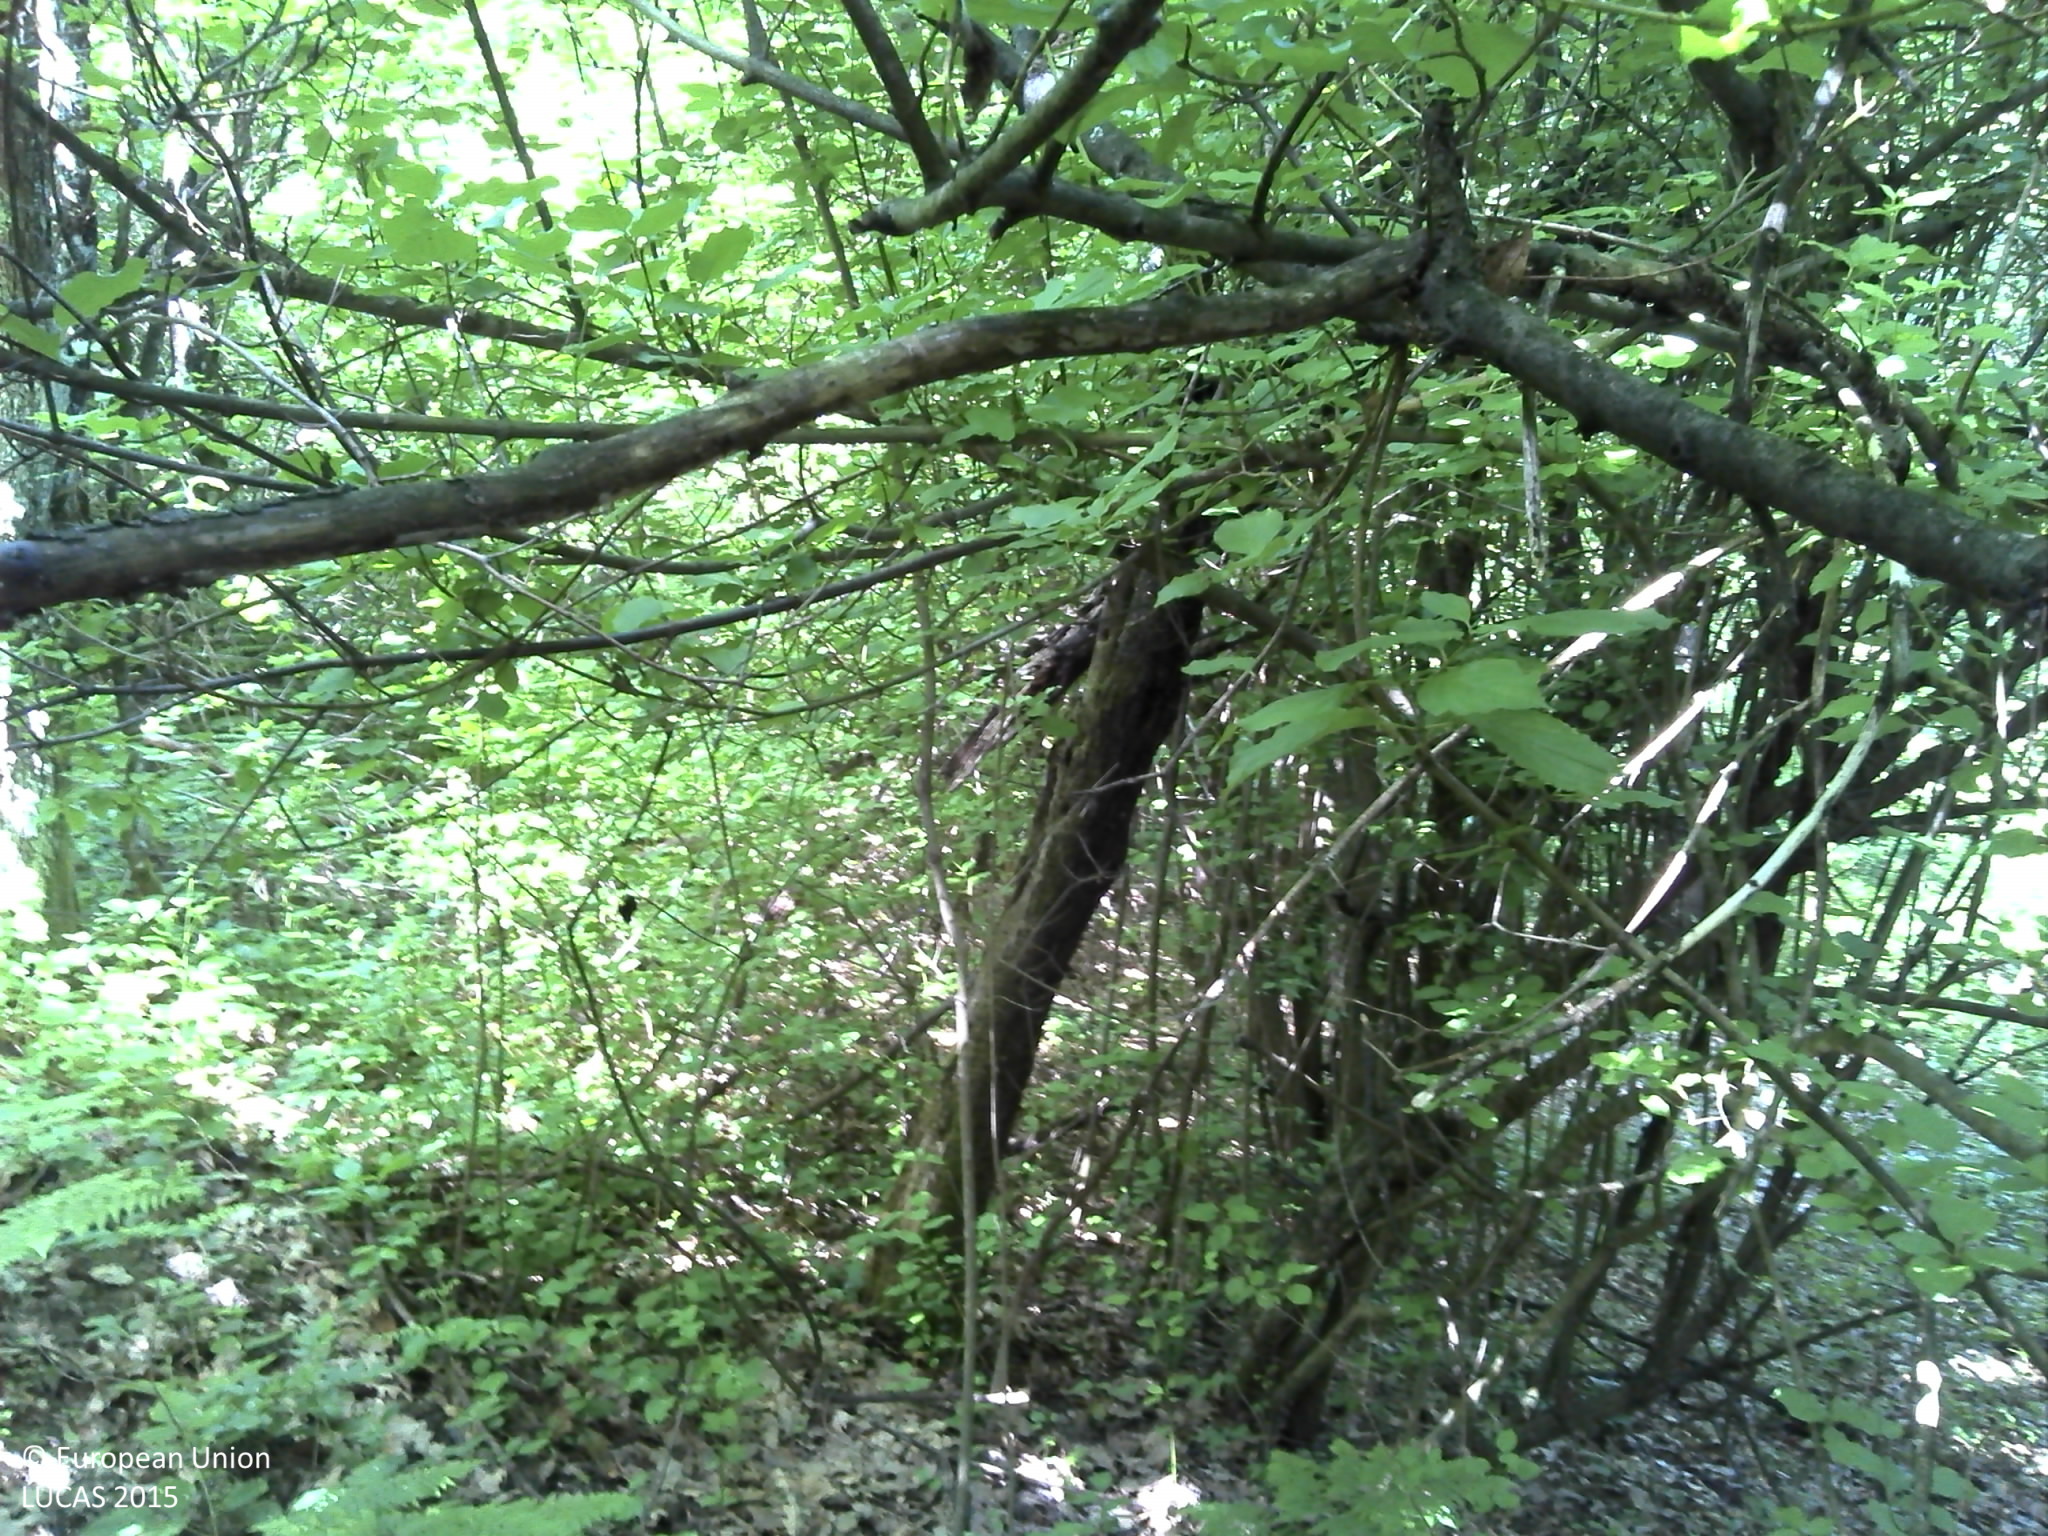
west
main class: Woodland
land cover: Broadleaved woodland
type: acidophilous oak and oak-birch forest
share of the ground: > 75 %
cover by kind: broadleaved forest trees 100 %
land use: Forestry
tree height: > 5 m
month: May
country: HR
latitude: 45.4344
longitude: 18.0184
